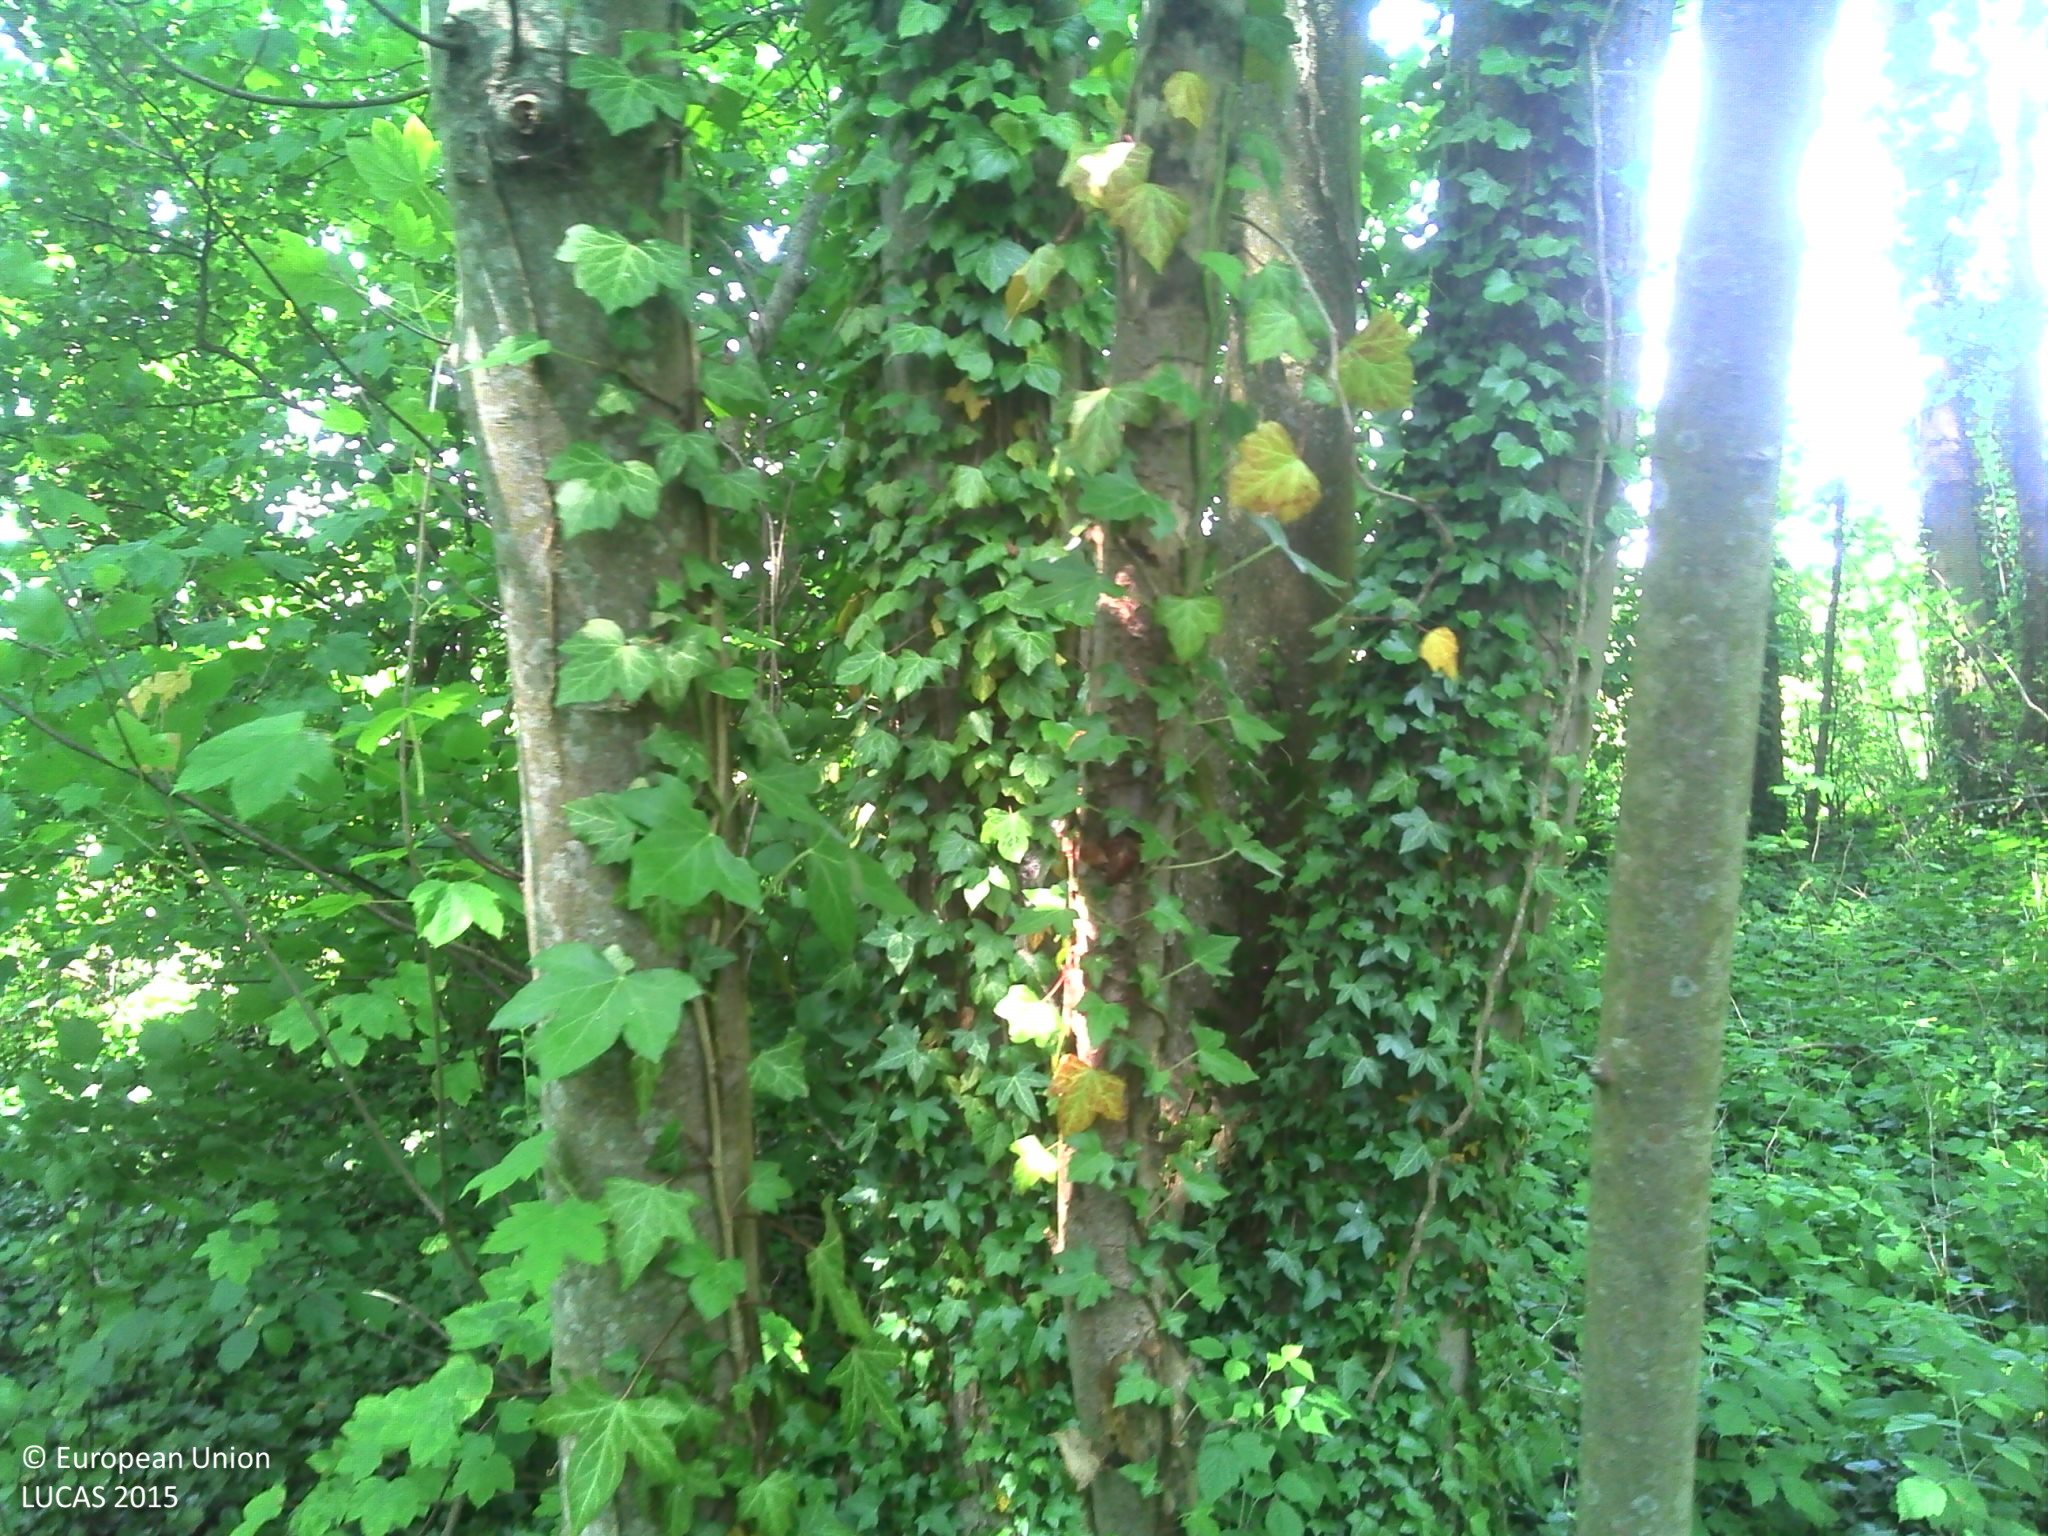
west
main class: Woodland
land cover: Broadleaved woodland
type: mesophytic deciduous forest
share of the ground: > 75 %
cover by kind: broadleaved forest trees 90 %, shrubs 5 %, herbaceous plants 5 %
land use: Semi-natural and natural areas not in use
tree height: > 5 m
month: June
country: FR
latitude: 49.5608
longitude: 4.0639
